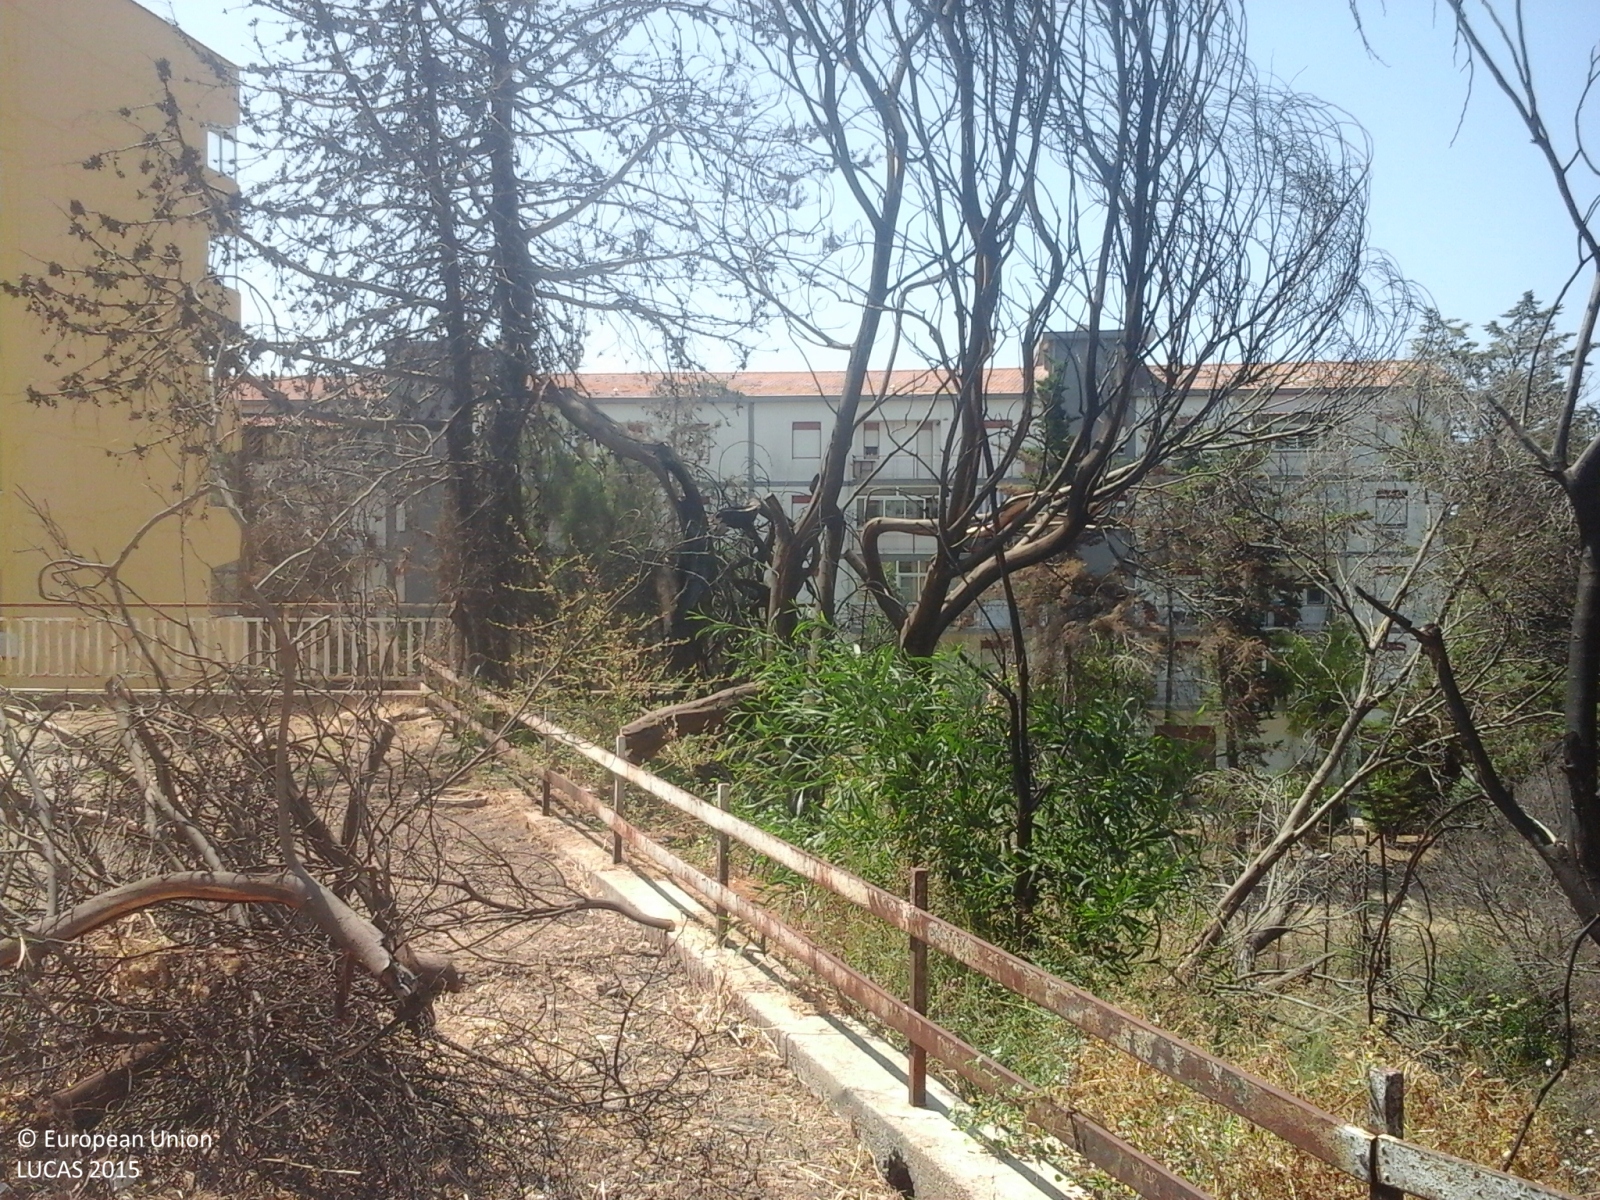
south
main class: Grassland
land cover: Grassland without tree/shrub cover
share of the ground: > 75 %
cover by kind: herbaceous plants 100 %
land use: Abandoned areas
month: July
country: IT
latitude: 37.2997
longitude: 13.5485
